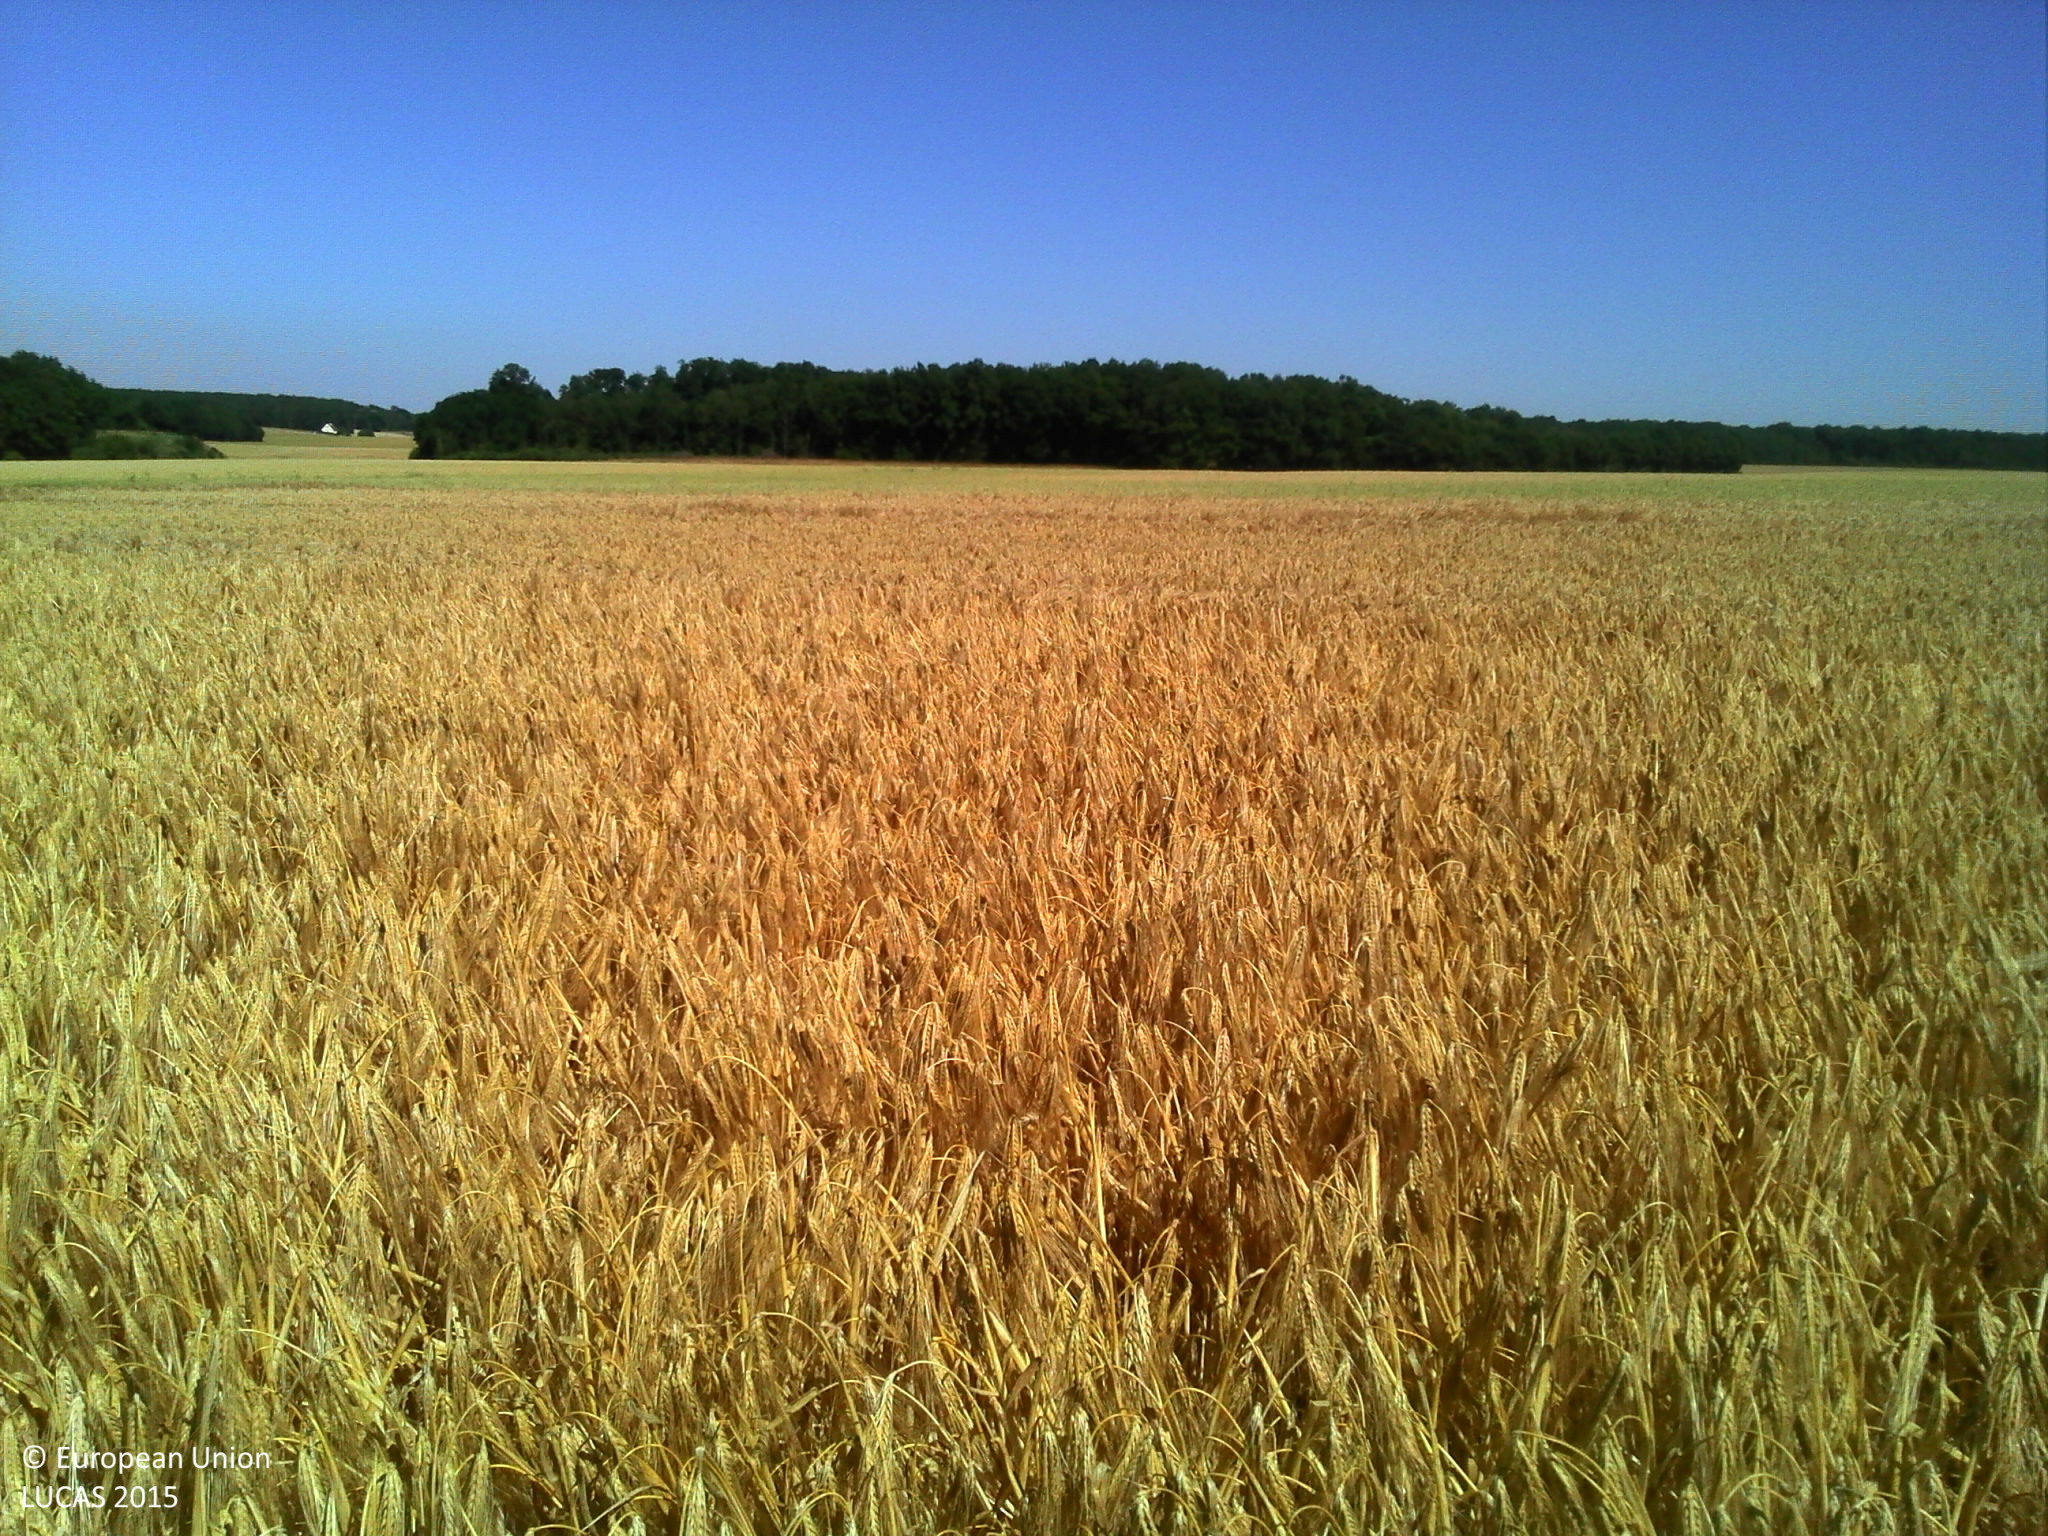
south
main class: Cropland
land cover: Barley
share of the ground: > 75 %
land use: Agriculture (excluding fallow land and kitchen gardens)
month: June
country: FR
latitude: 48.9789
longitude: 1.2497
